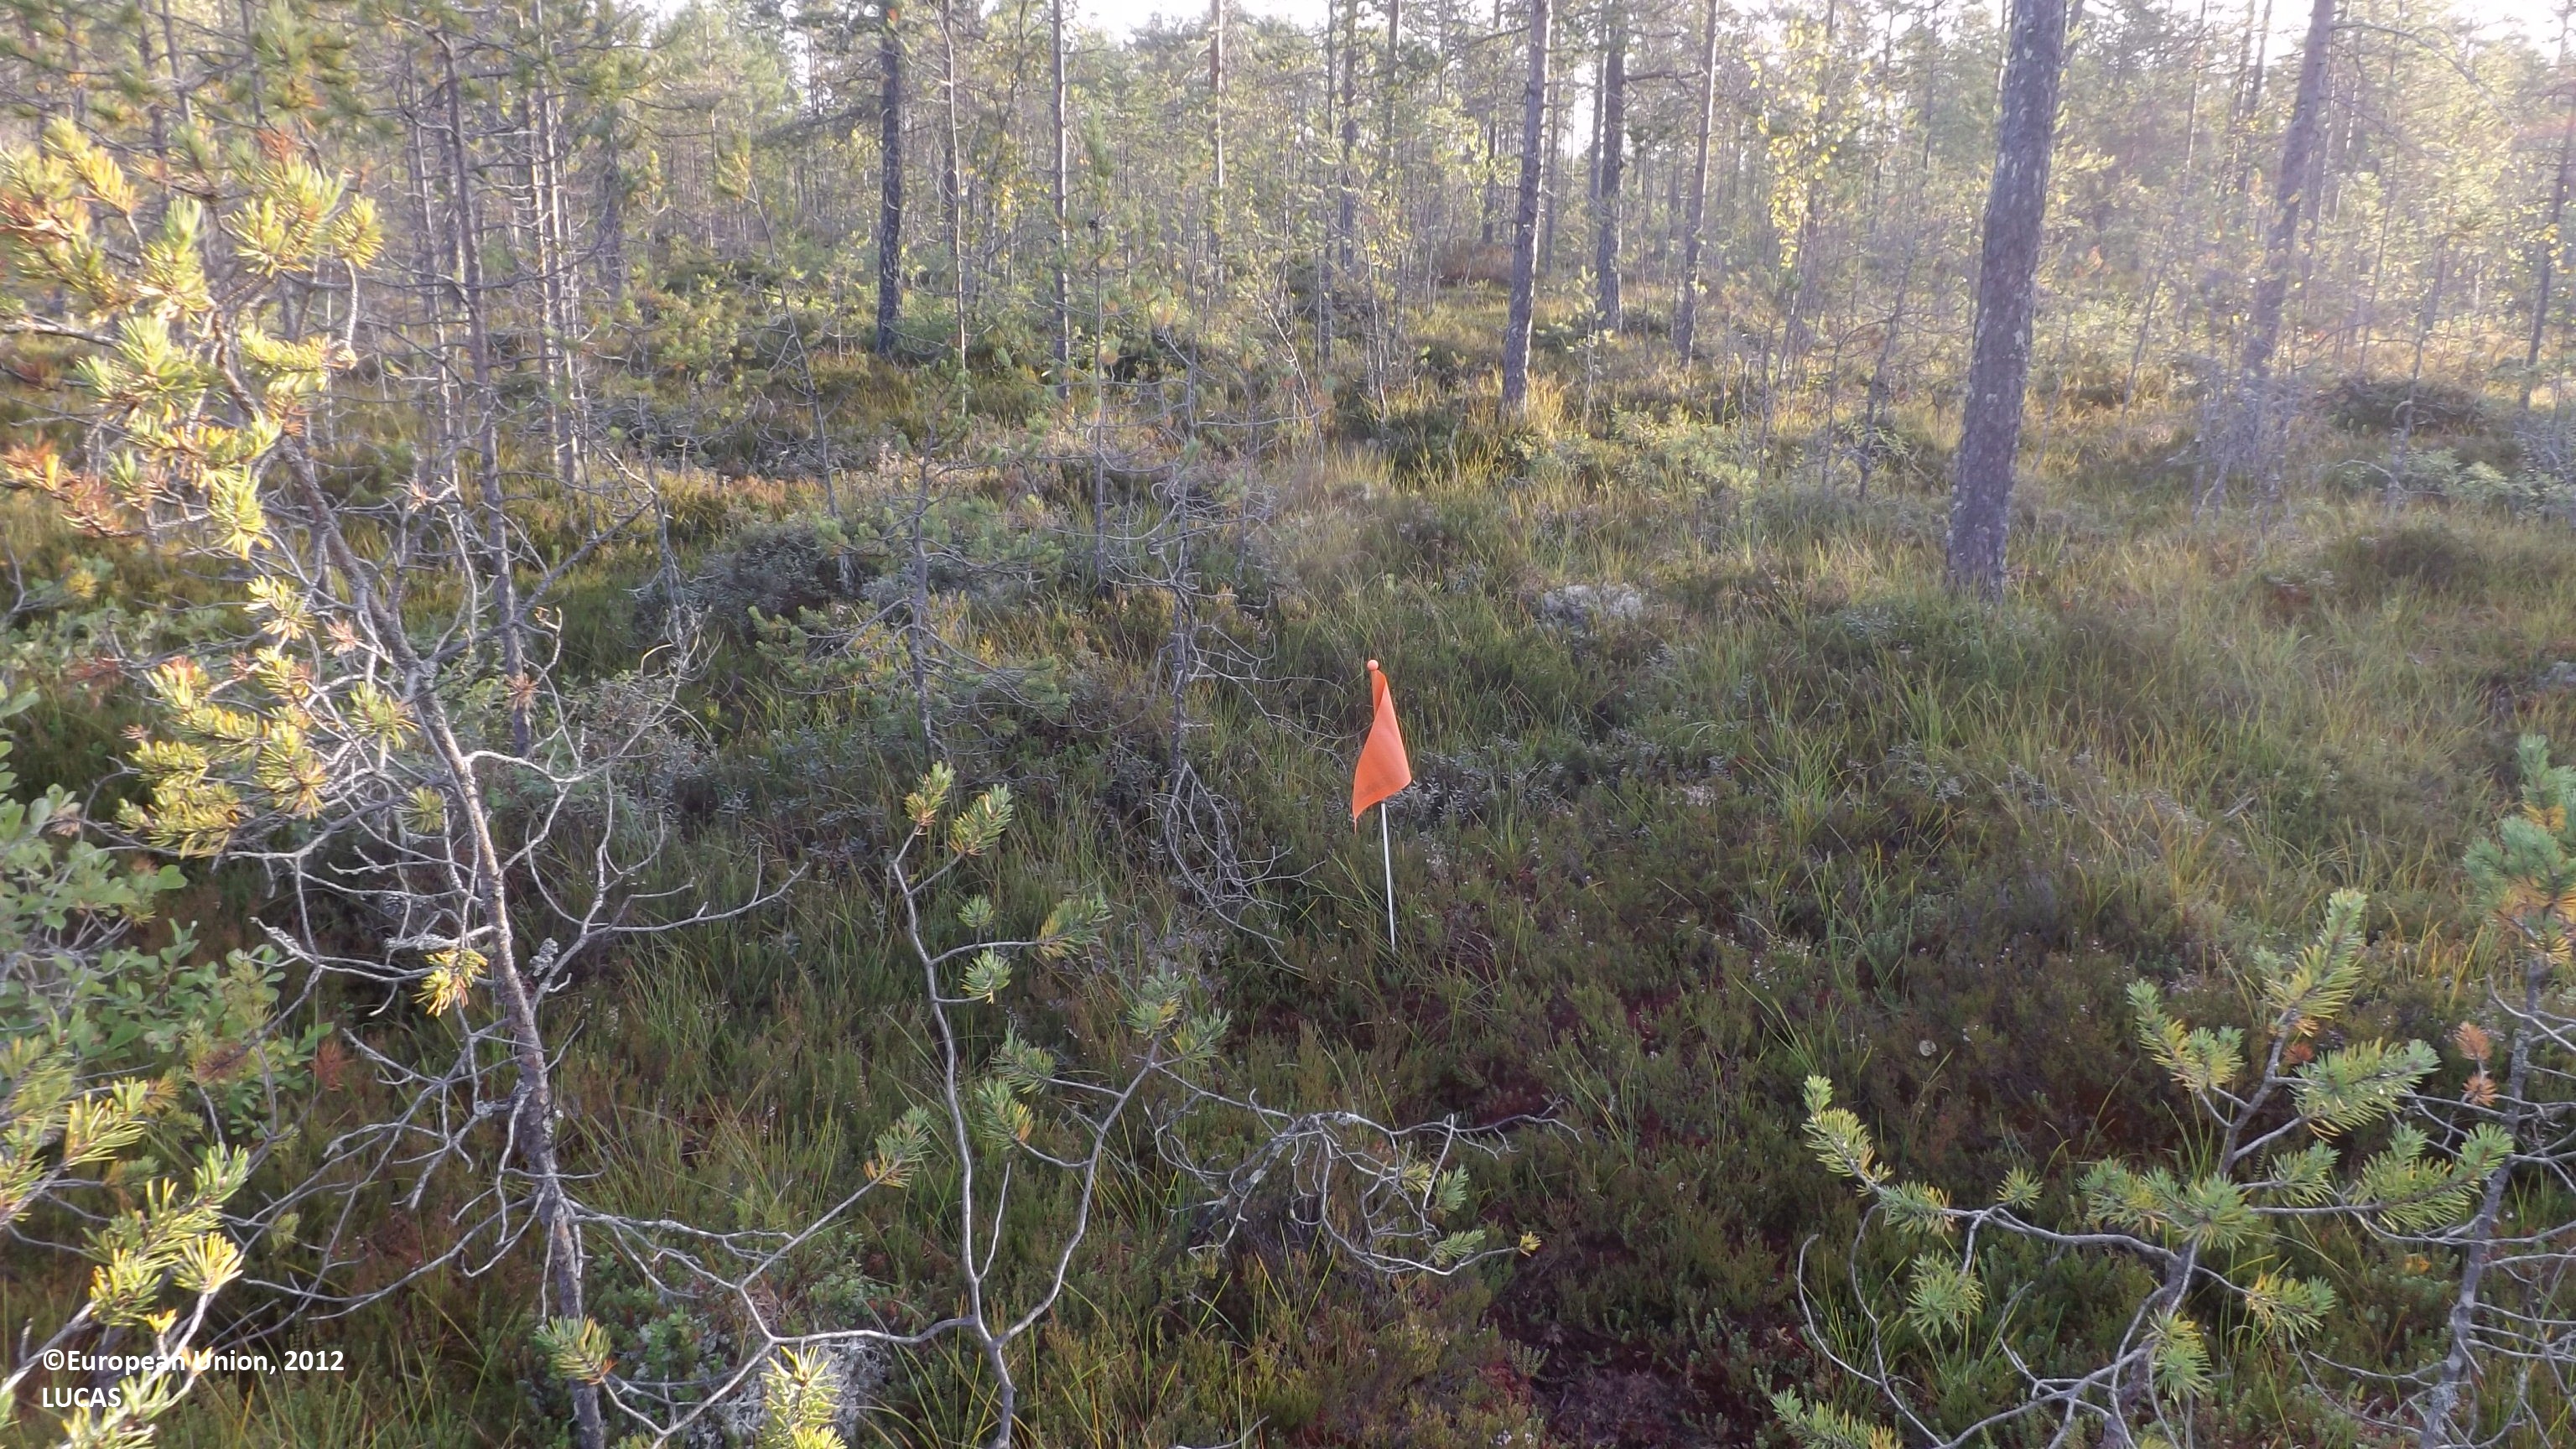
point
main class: Woodland
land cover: Pine dominated coniferous woodland
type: mire and swamp forests
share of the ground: 10 - 25 %
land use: Forestry
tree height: < 5 m
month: August
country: FI
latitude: 63.8015
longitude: 24.0979
